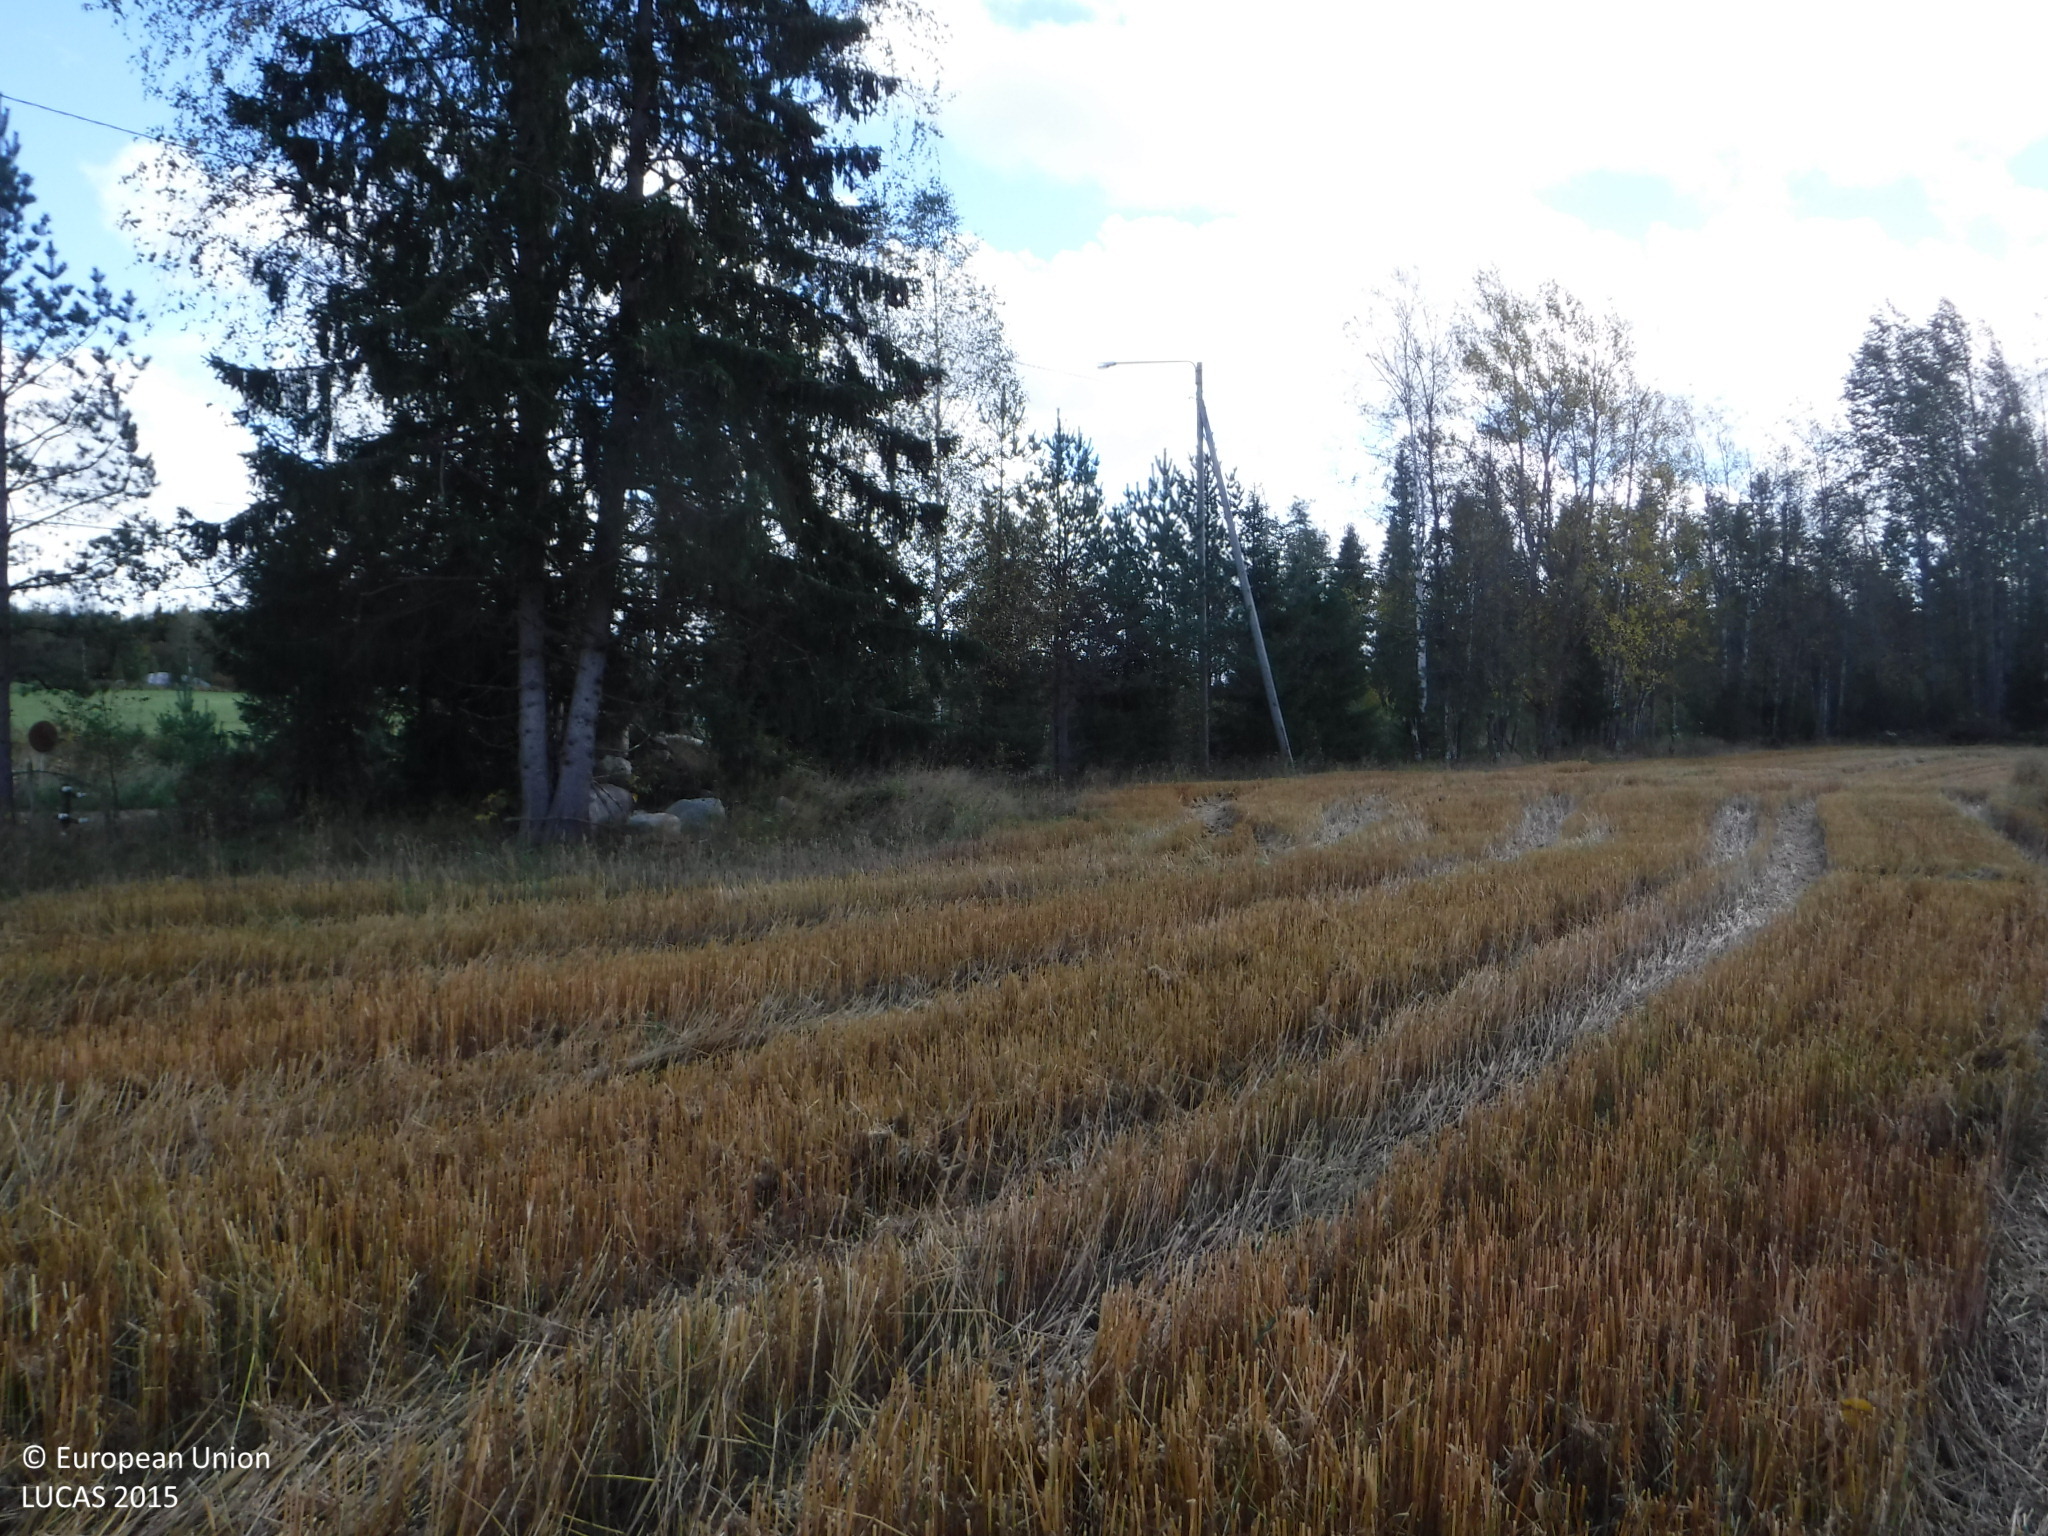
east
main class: Cropland
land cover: Oats
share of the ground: > 75 %
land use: Agriculture (excluding fallow land and kitchen gardens)
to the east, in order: Oats; Grass margins; Abandoned hedges; Electric lines; Ditches and canals; Paved roads, cycling and walking lanes; Electric lines; Paved roads, cycling and walking lanes; Grass margins; Ditches and canals; Grass margins; Other leguminous and mixtures for fodder; Grass margins; Abandoned hedges; Ditches and canals; Abandoned hedges; Other leguminous and mixtures for fodder; Electric lines; Other leguminous and mixtures for fodder; Spontaneously vegetated surfaces
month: September
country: FI
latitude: 62.0987
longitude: 21.7146
